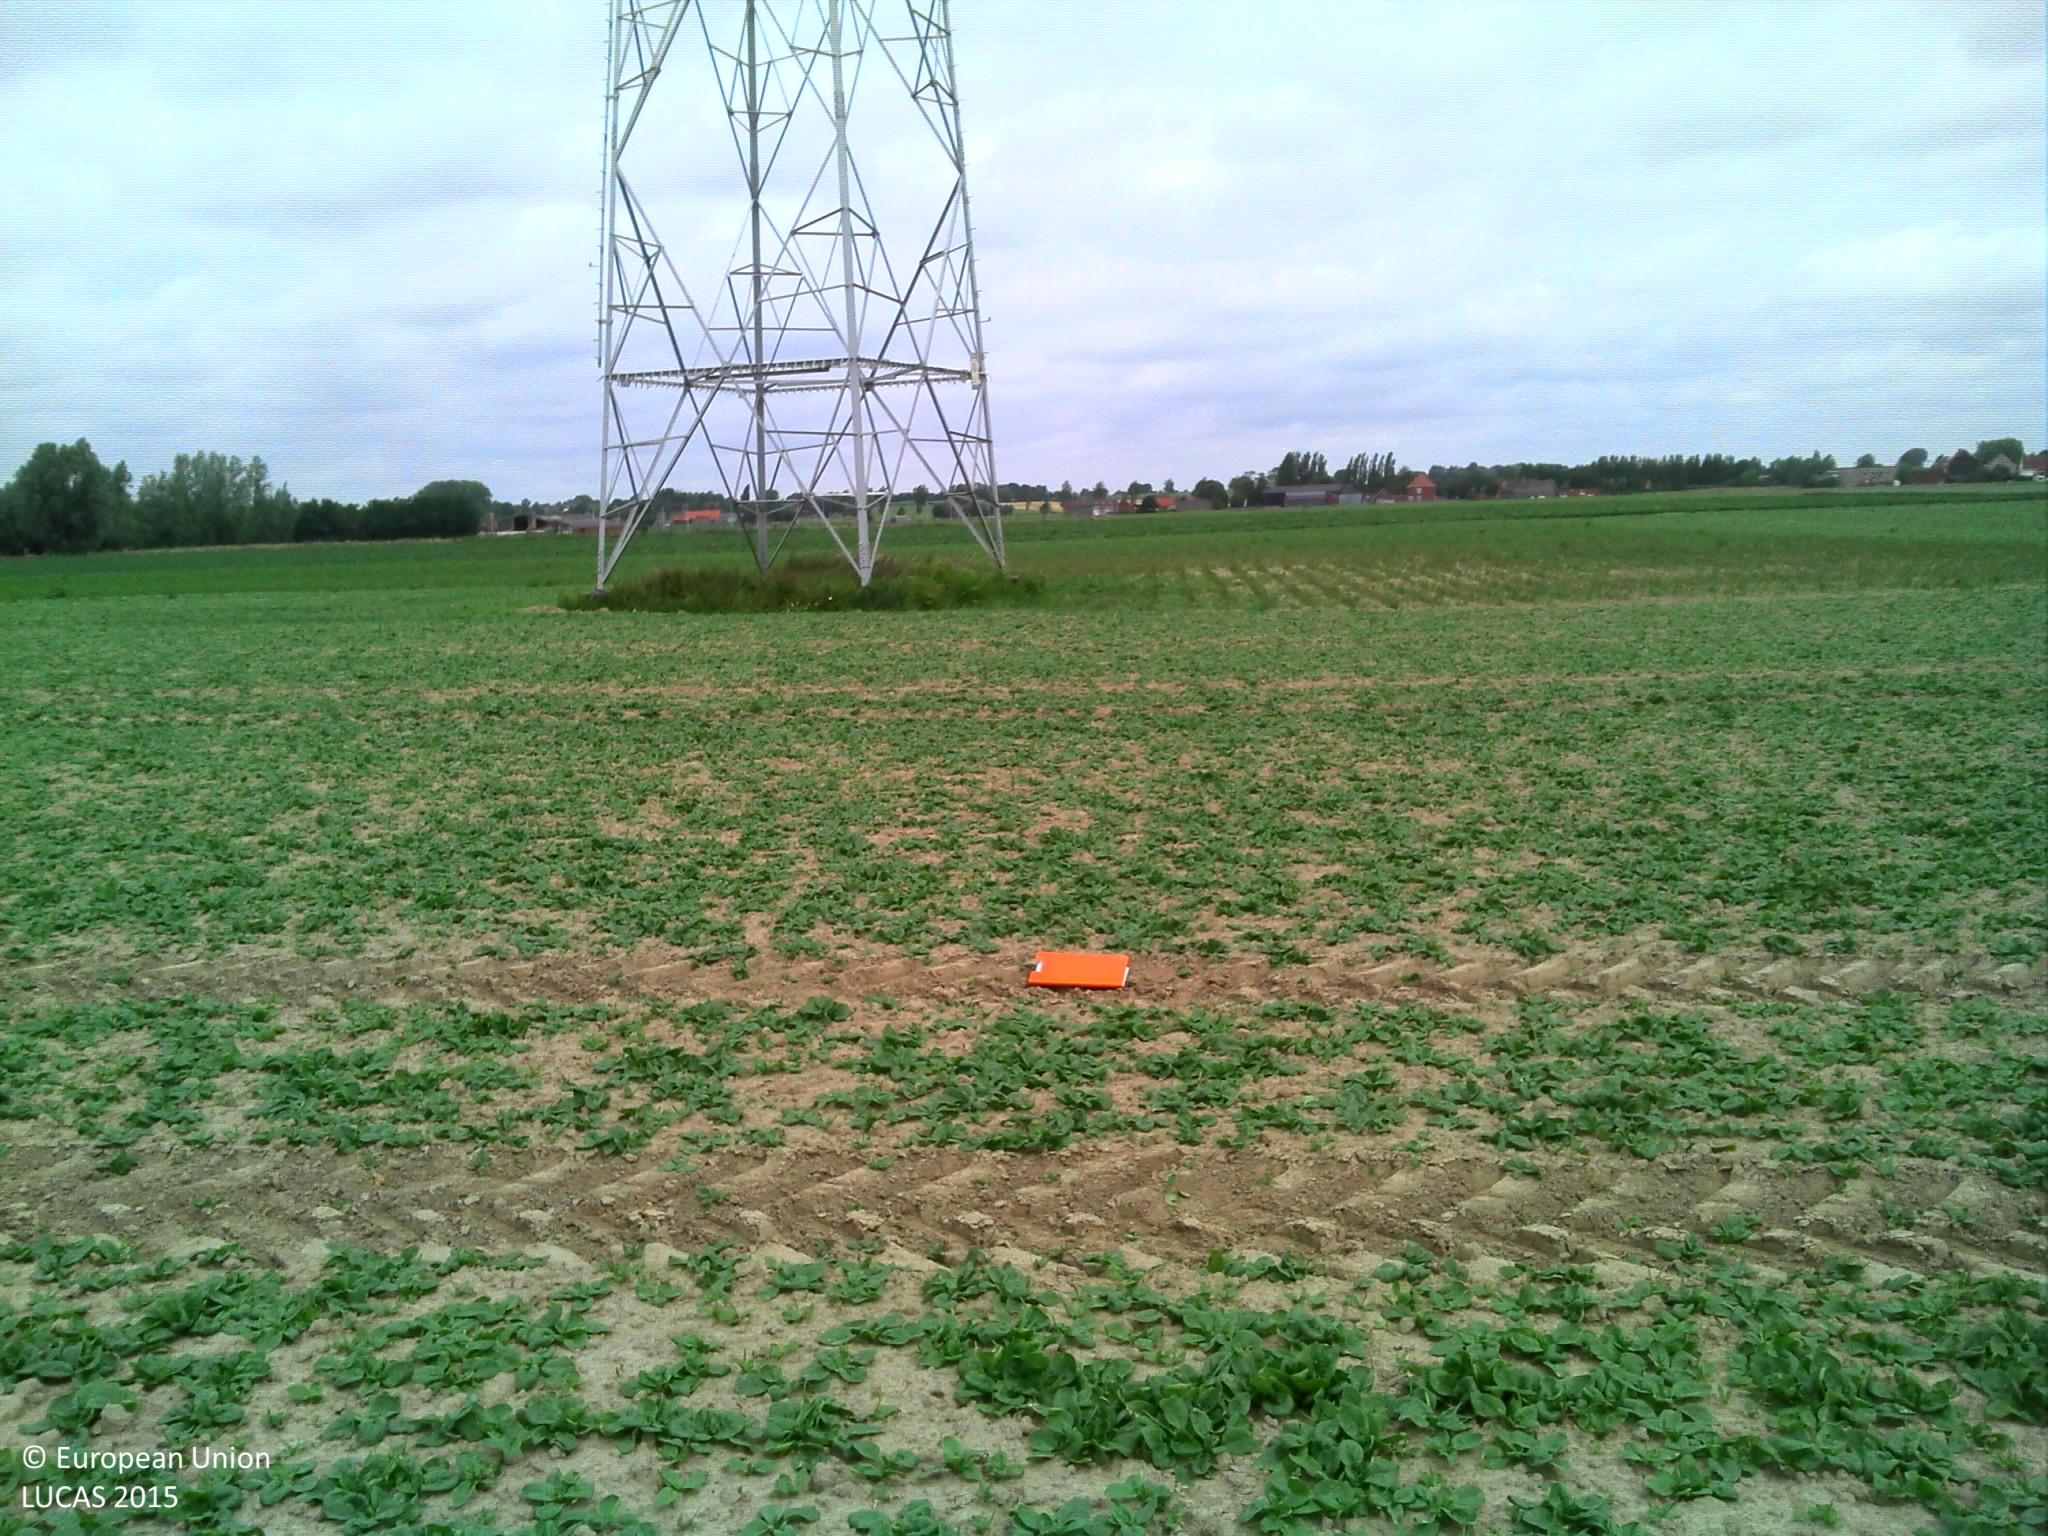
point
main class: Cropland
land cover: Other fresh vegetables
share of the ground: 50 - 75 %
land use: Agriculture (excluding fallow land and kitchen gardens)
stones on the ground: < 10 %
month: June
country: BE
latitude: 50.9685
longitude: 3.1125
